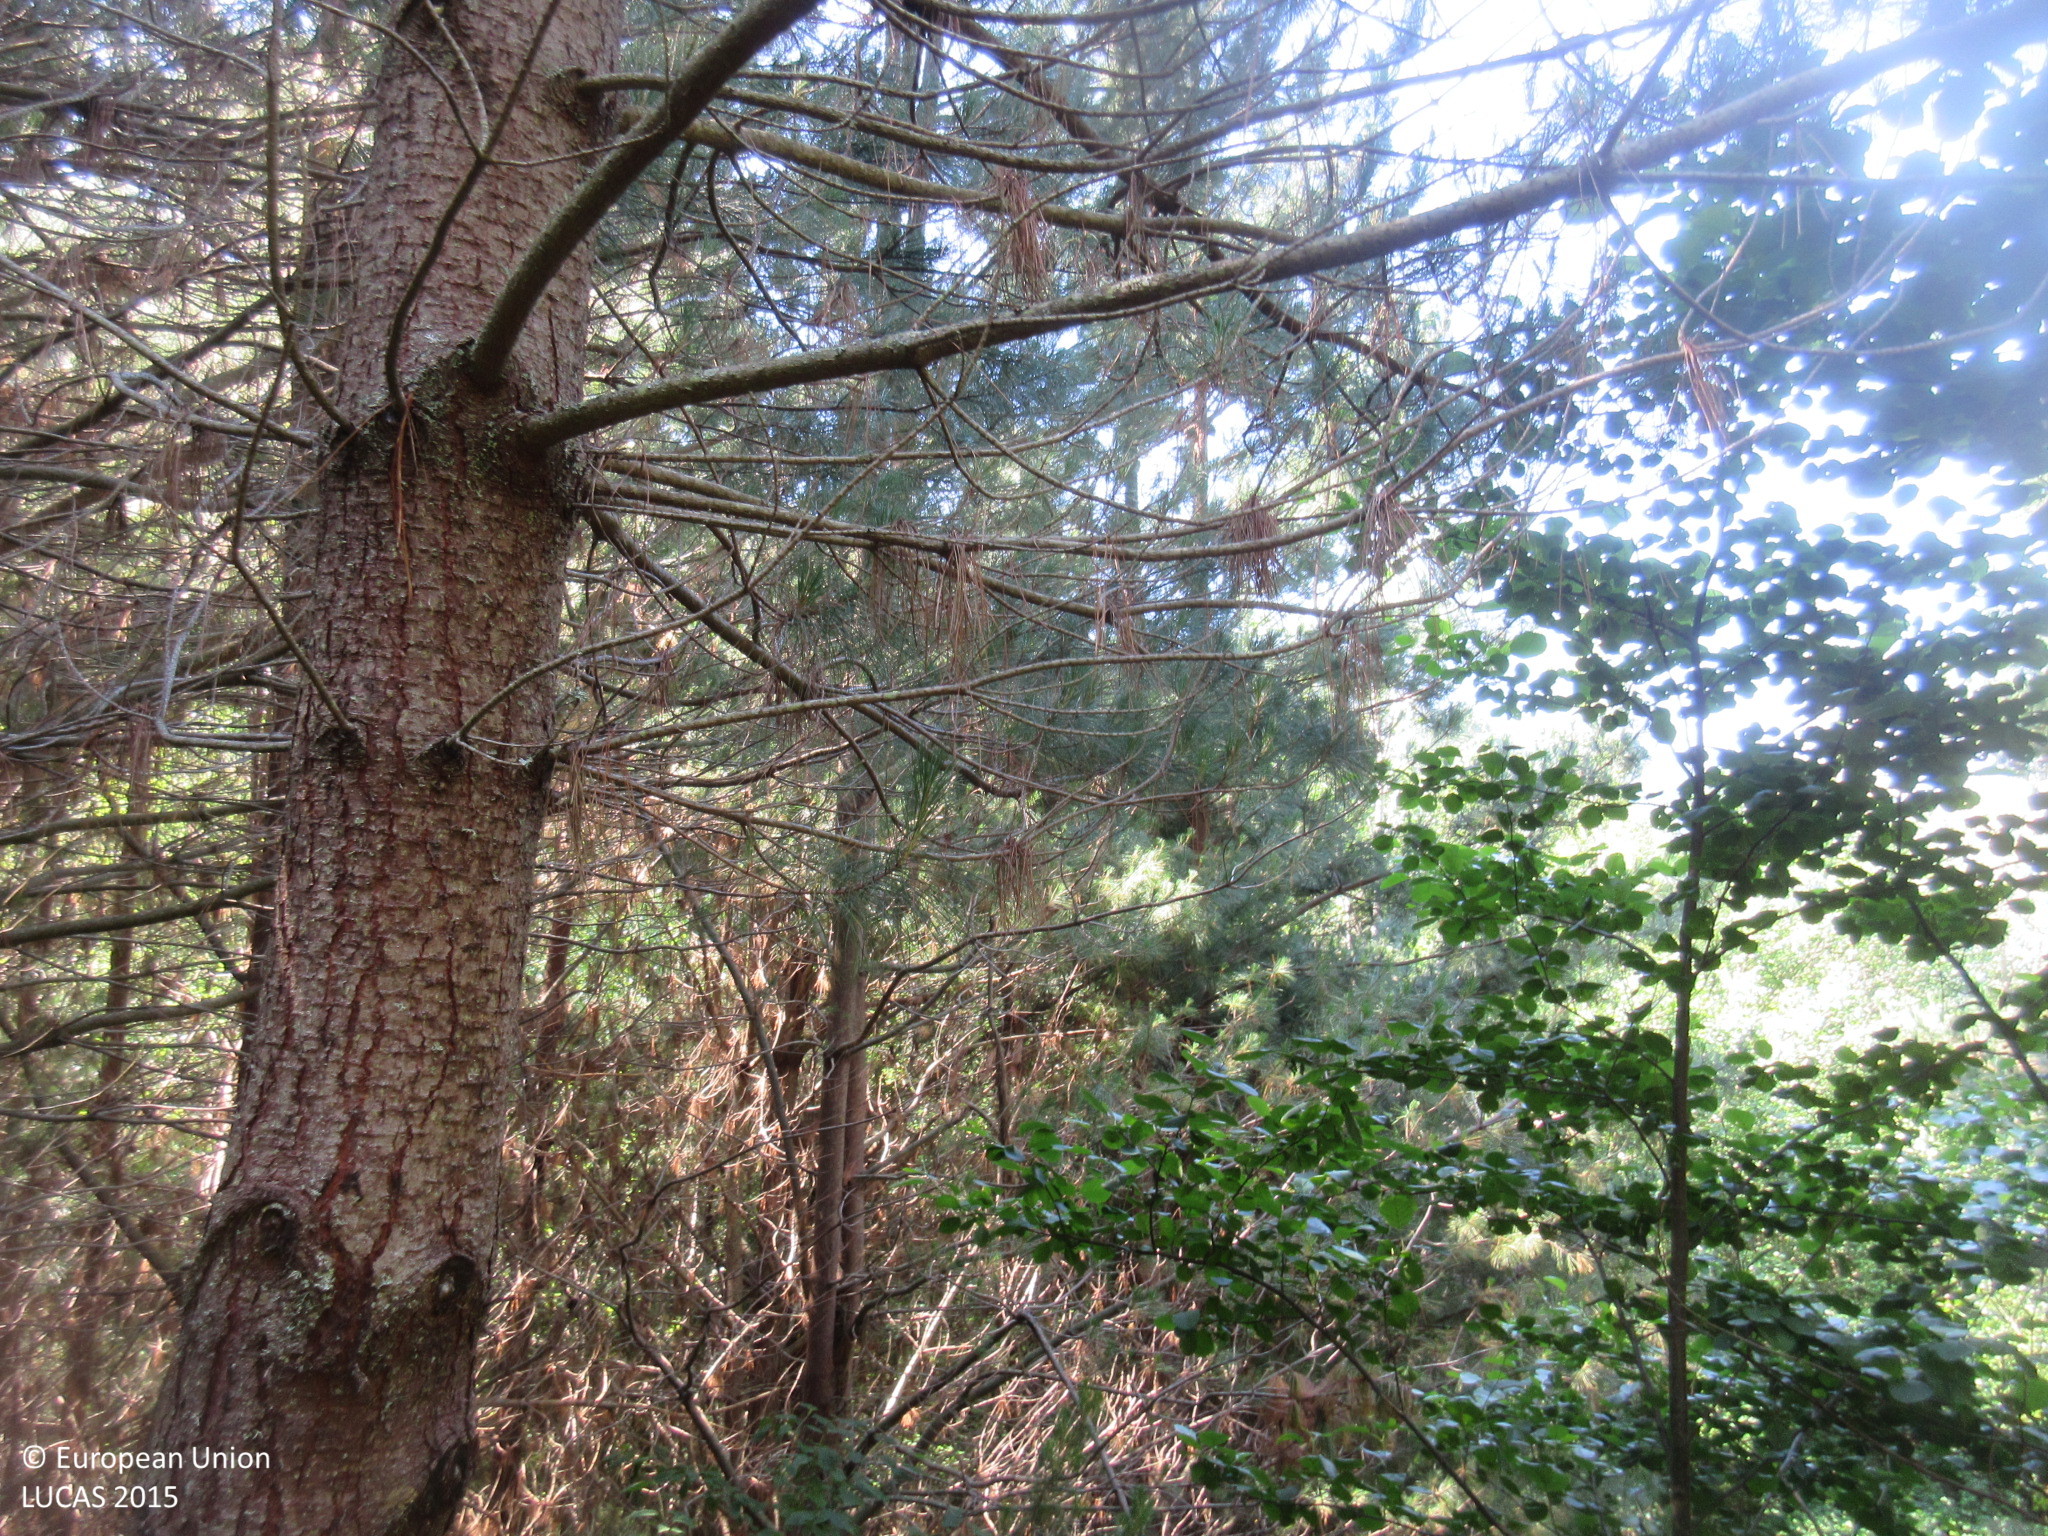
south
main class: Woodland
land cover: Pine dominated mixed woodland
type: hemiboreal forest and nemoral coniferous forest and mixed broadleaved-coniferous forest
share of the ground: > 75 %
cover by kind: coniferous forest trees 55 %, shrubs 25 %, broadleaved forest trees 20 %
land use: Forestry
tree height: > 5 m
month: June
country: ES
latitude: 42.8853
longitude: -6.9689
